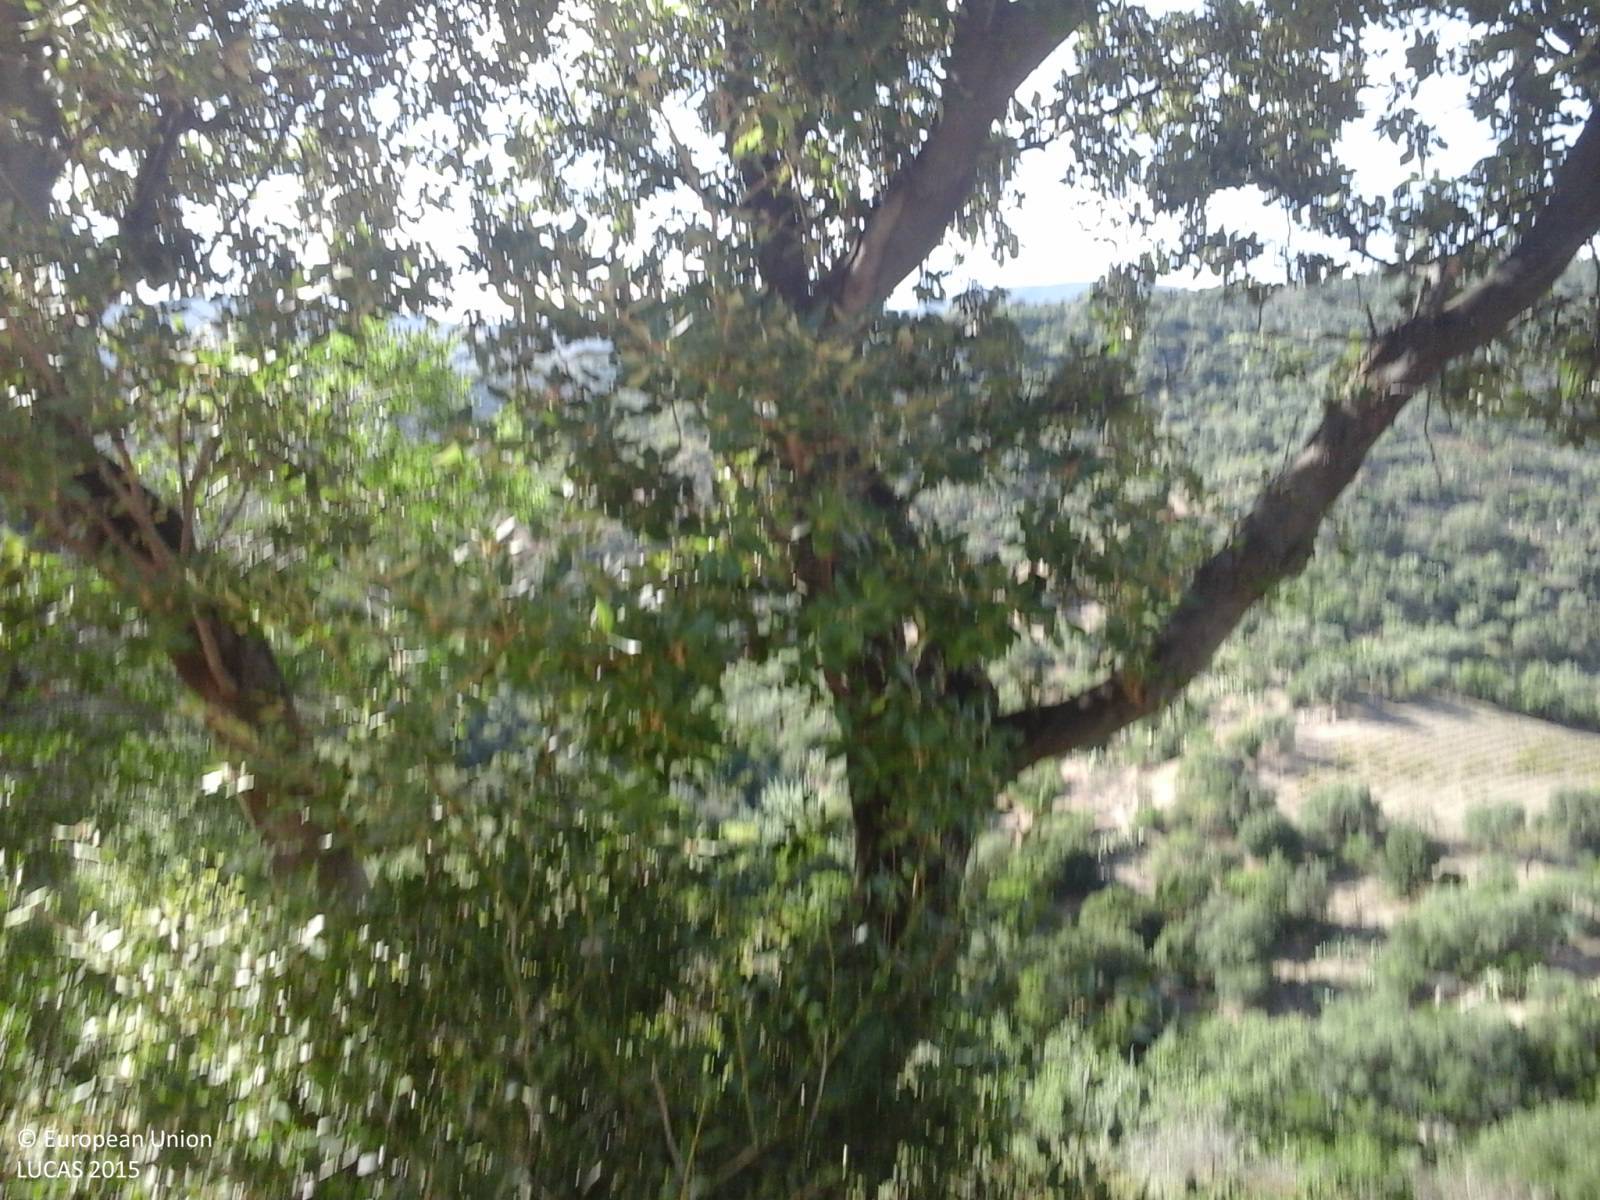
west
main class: Woodland
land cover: Broadleaved woodland
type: broadleaved evergreen forest
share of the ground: > 75 %
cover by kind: broadleaved forest trees 75 %, unconsolidated bare surface 15 %, shrubs 5 %, herbaceous plants 5 %
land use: Semi-natural and natural areas not in use
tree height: > 5 m
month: September
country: IT
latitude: 39.9043
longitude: 9.5696
